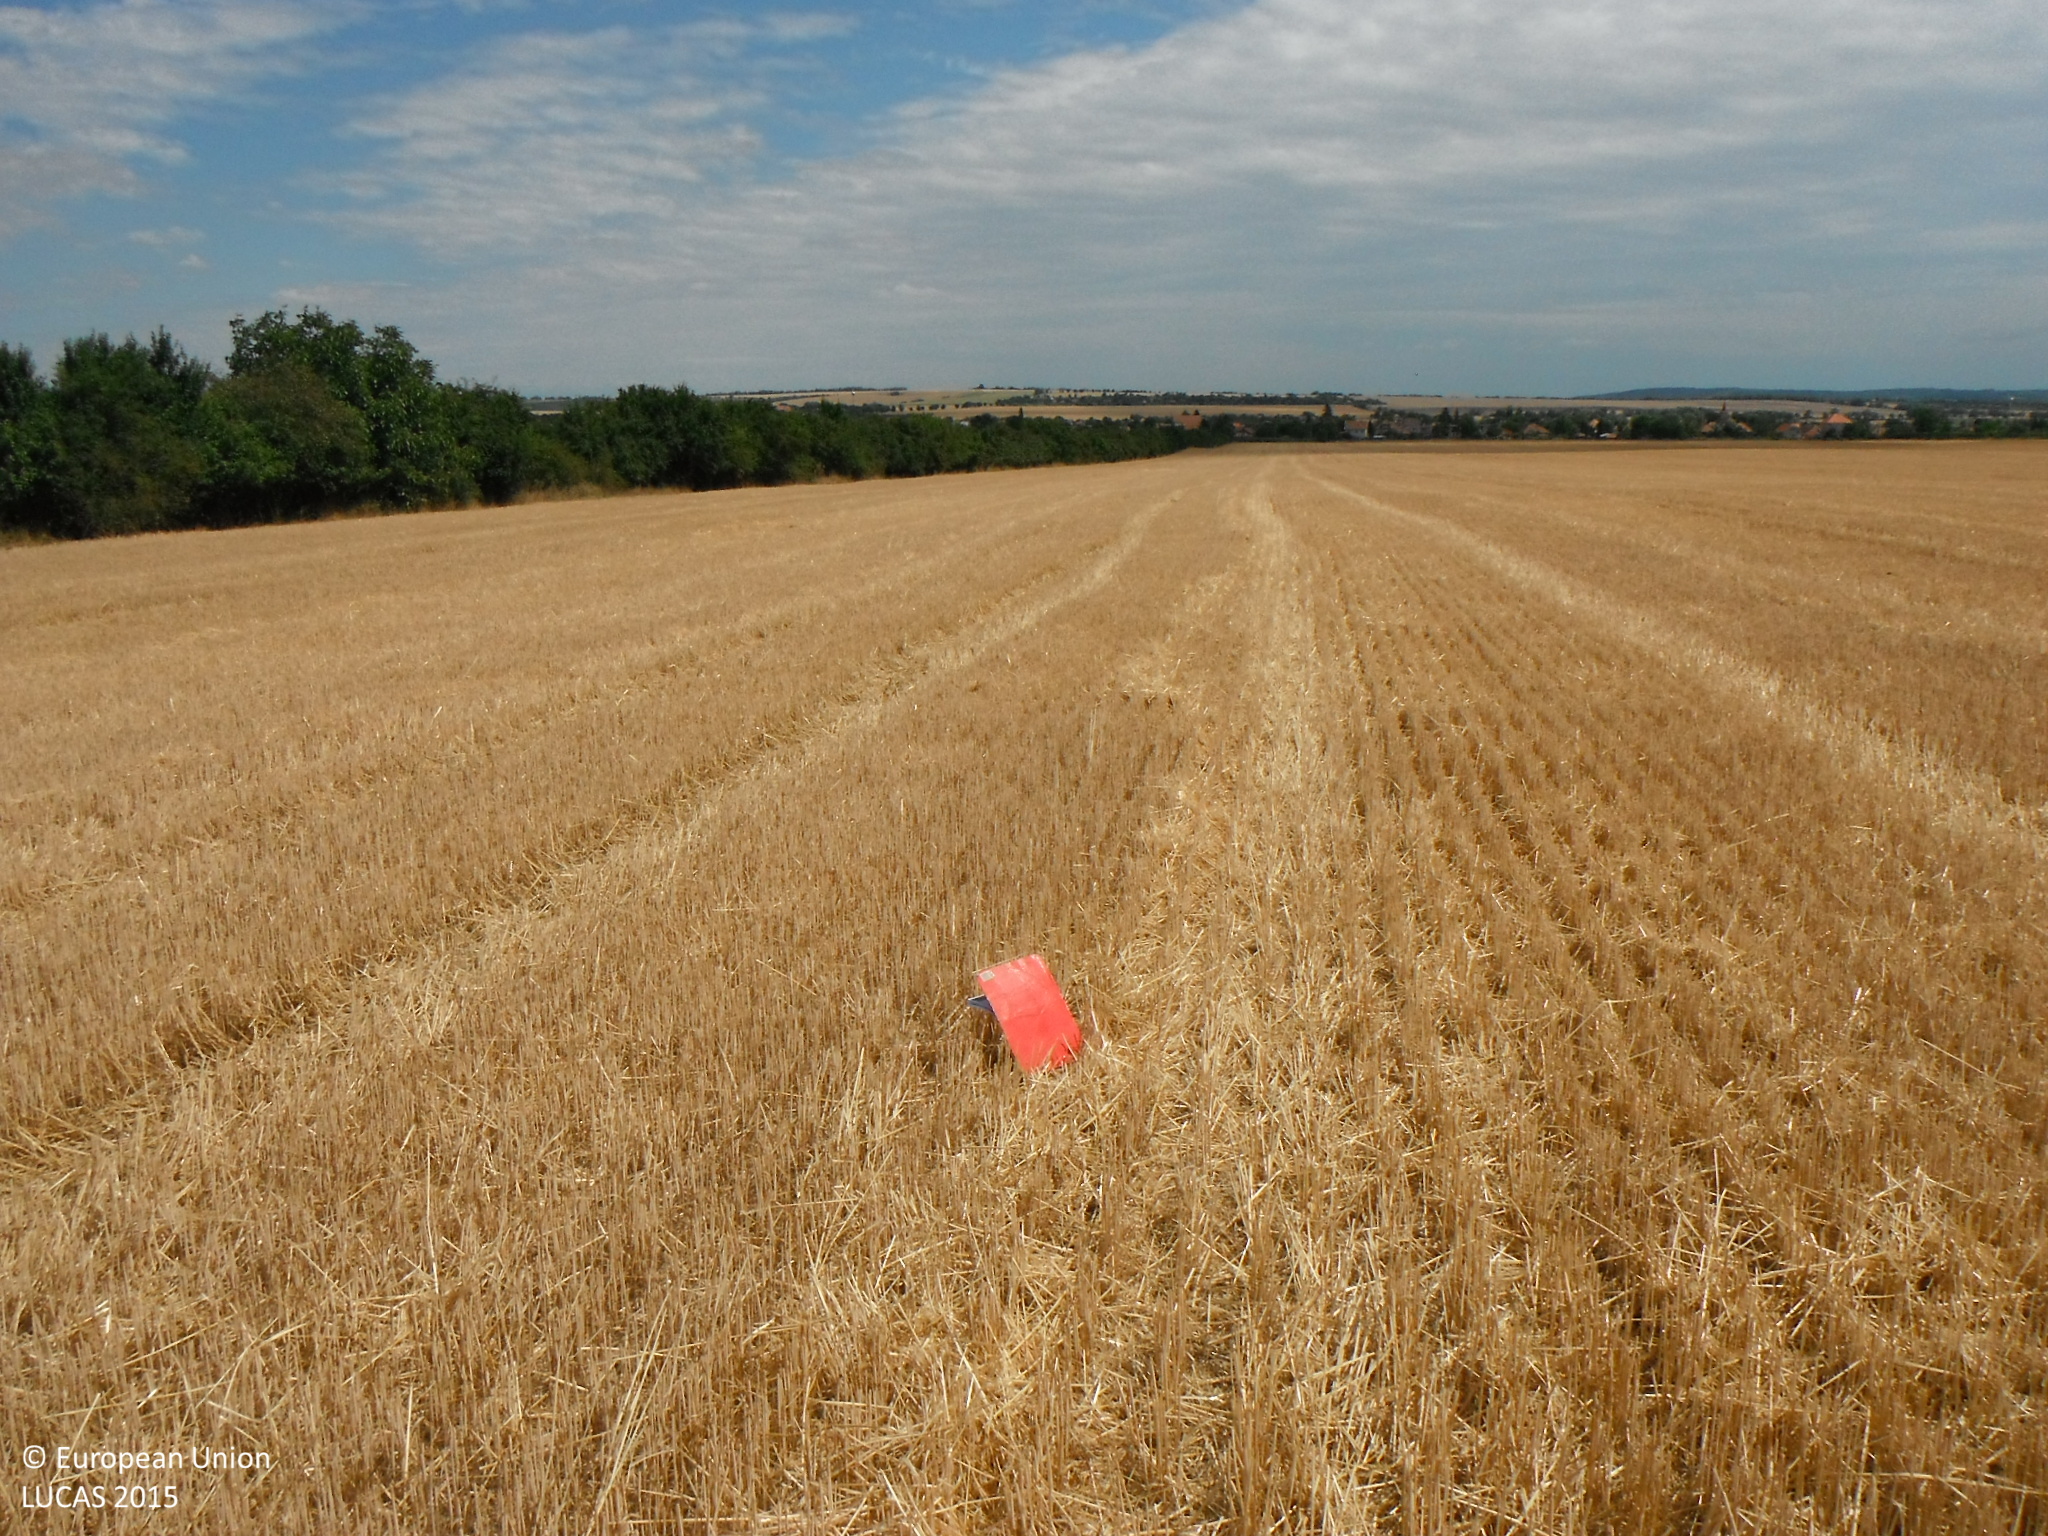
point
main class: Cropland
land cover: Common wheat
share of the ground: > 75 %
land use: Agriculture (excluding fallow land and kitchen gardens)
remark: Harvested field
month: July
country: SK
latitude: 48.1488
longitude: 18.2537
